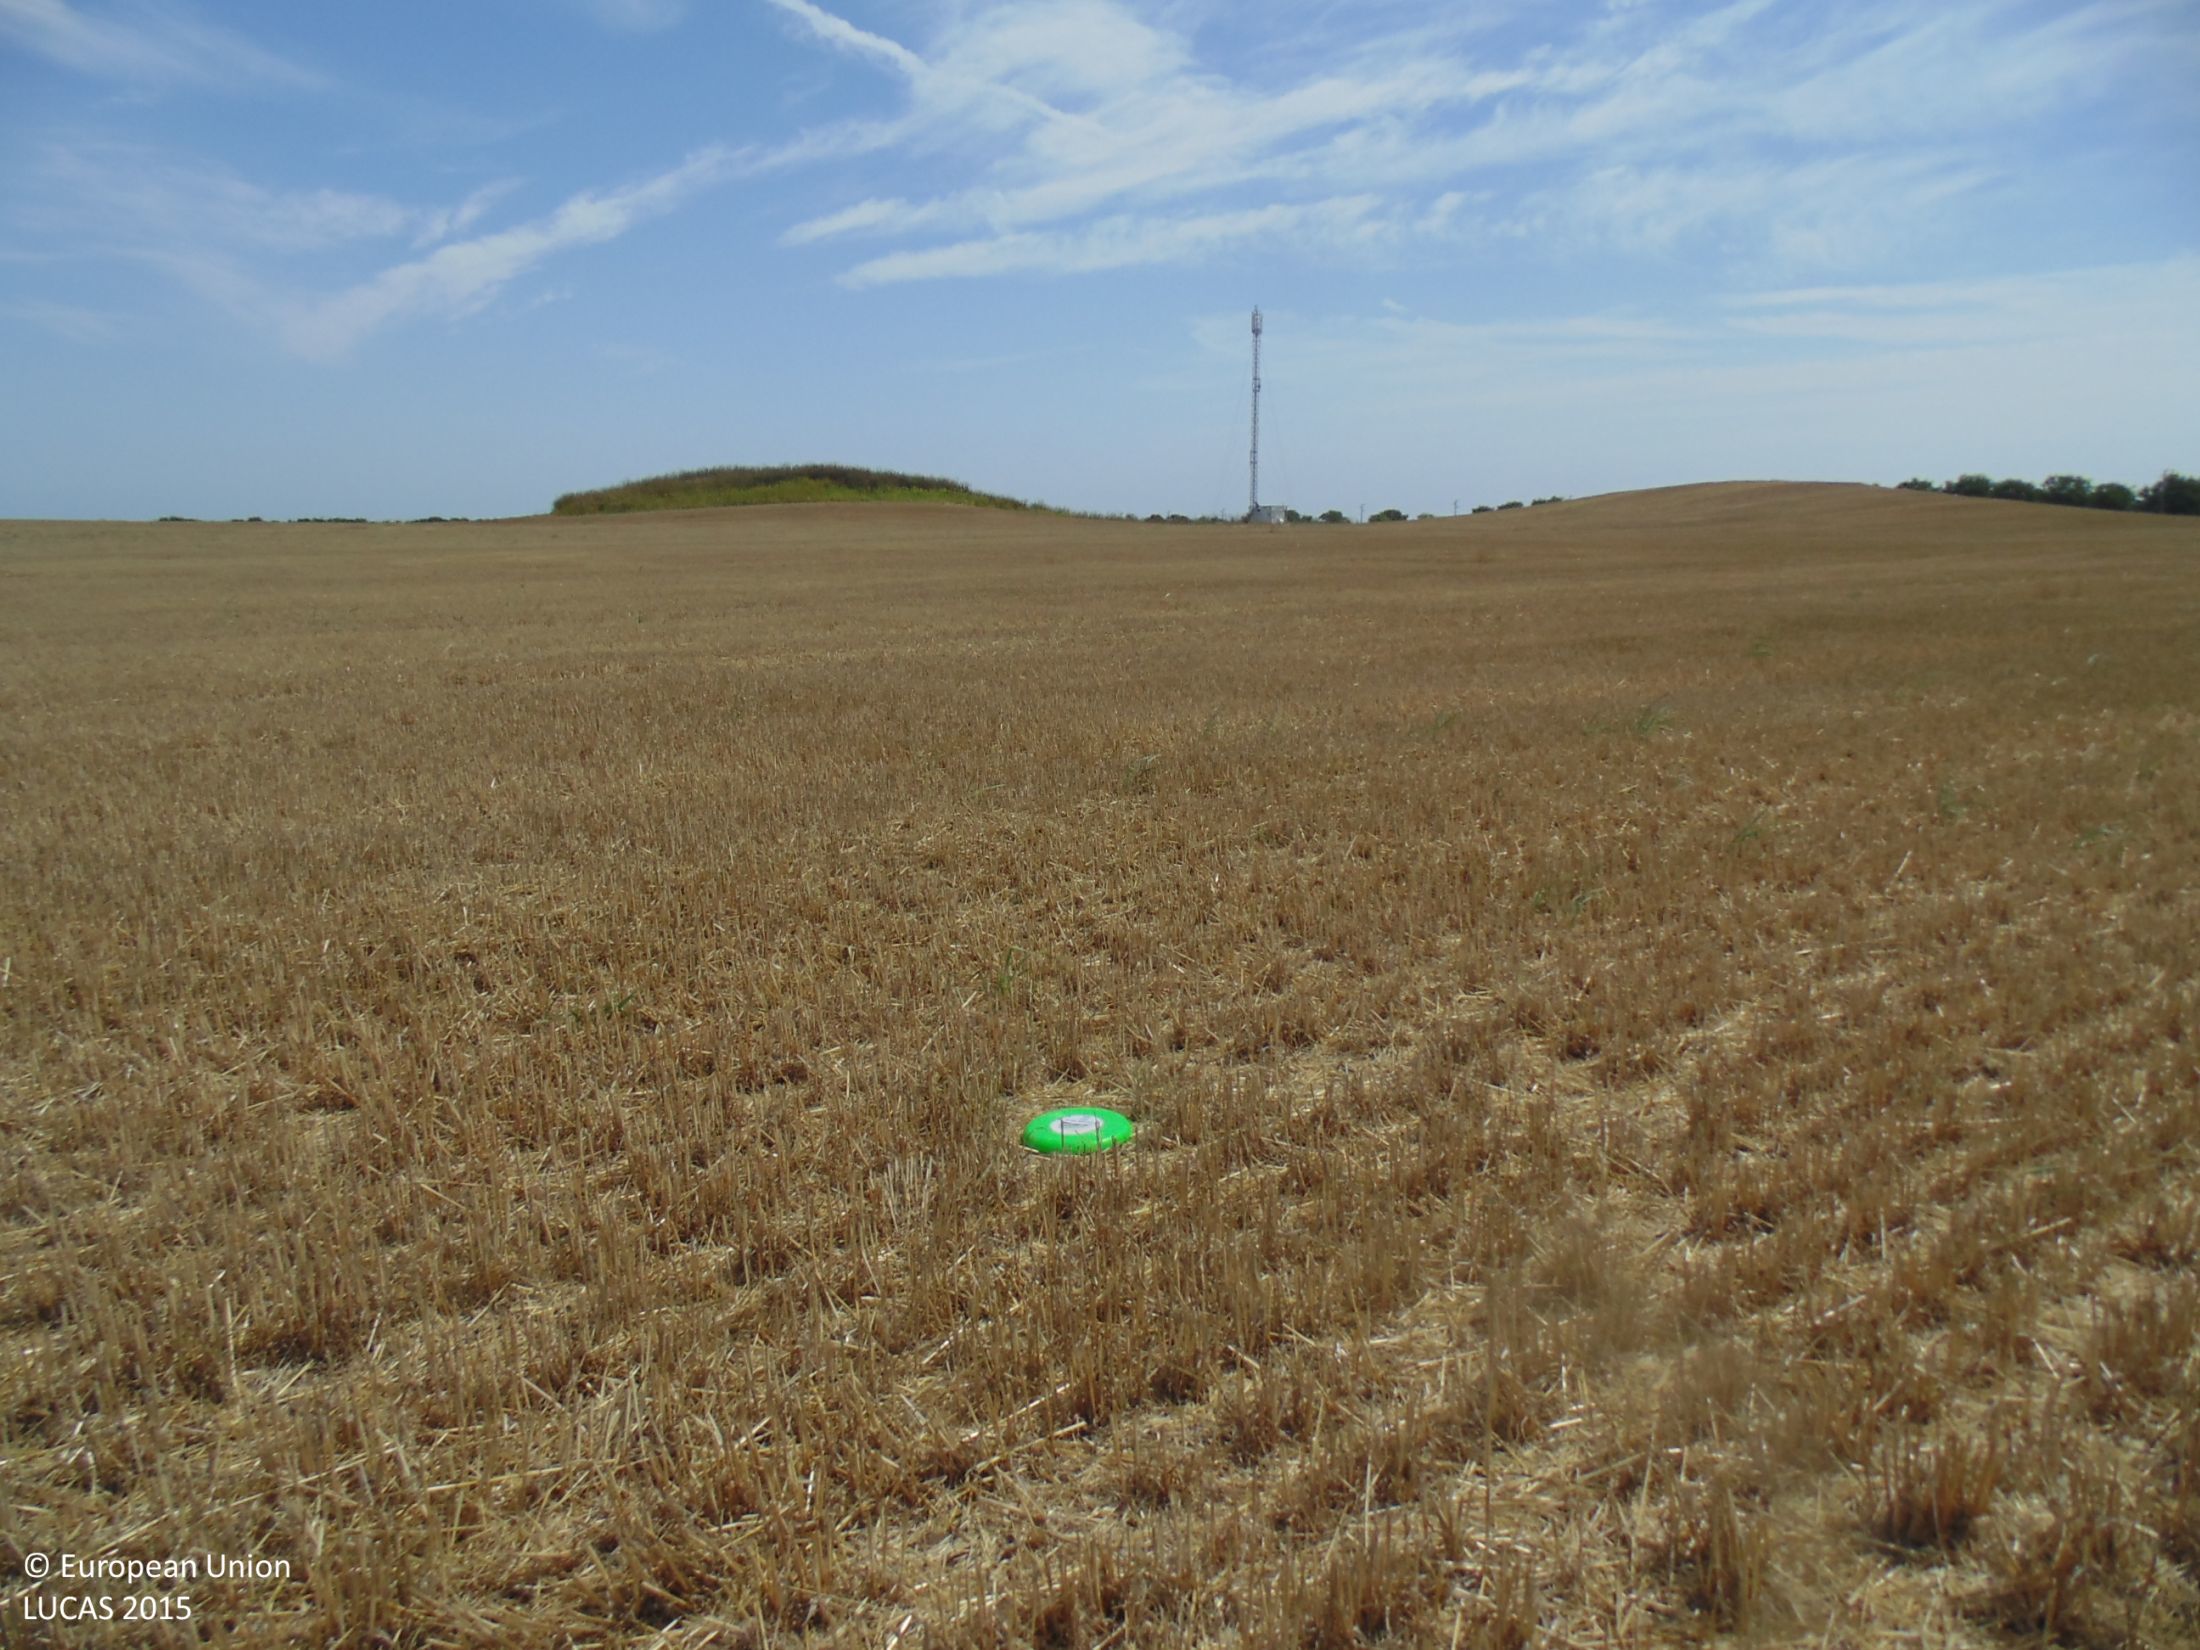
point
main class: Cropland
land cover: Common wheat
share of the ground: 25 - 50 %
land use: Agriculture (excluding fallow land and kitchen gardens)
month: August
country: BG
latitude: 43.6262
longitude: 28.5178
